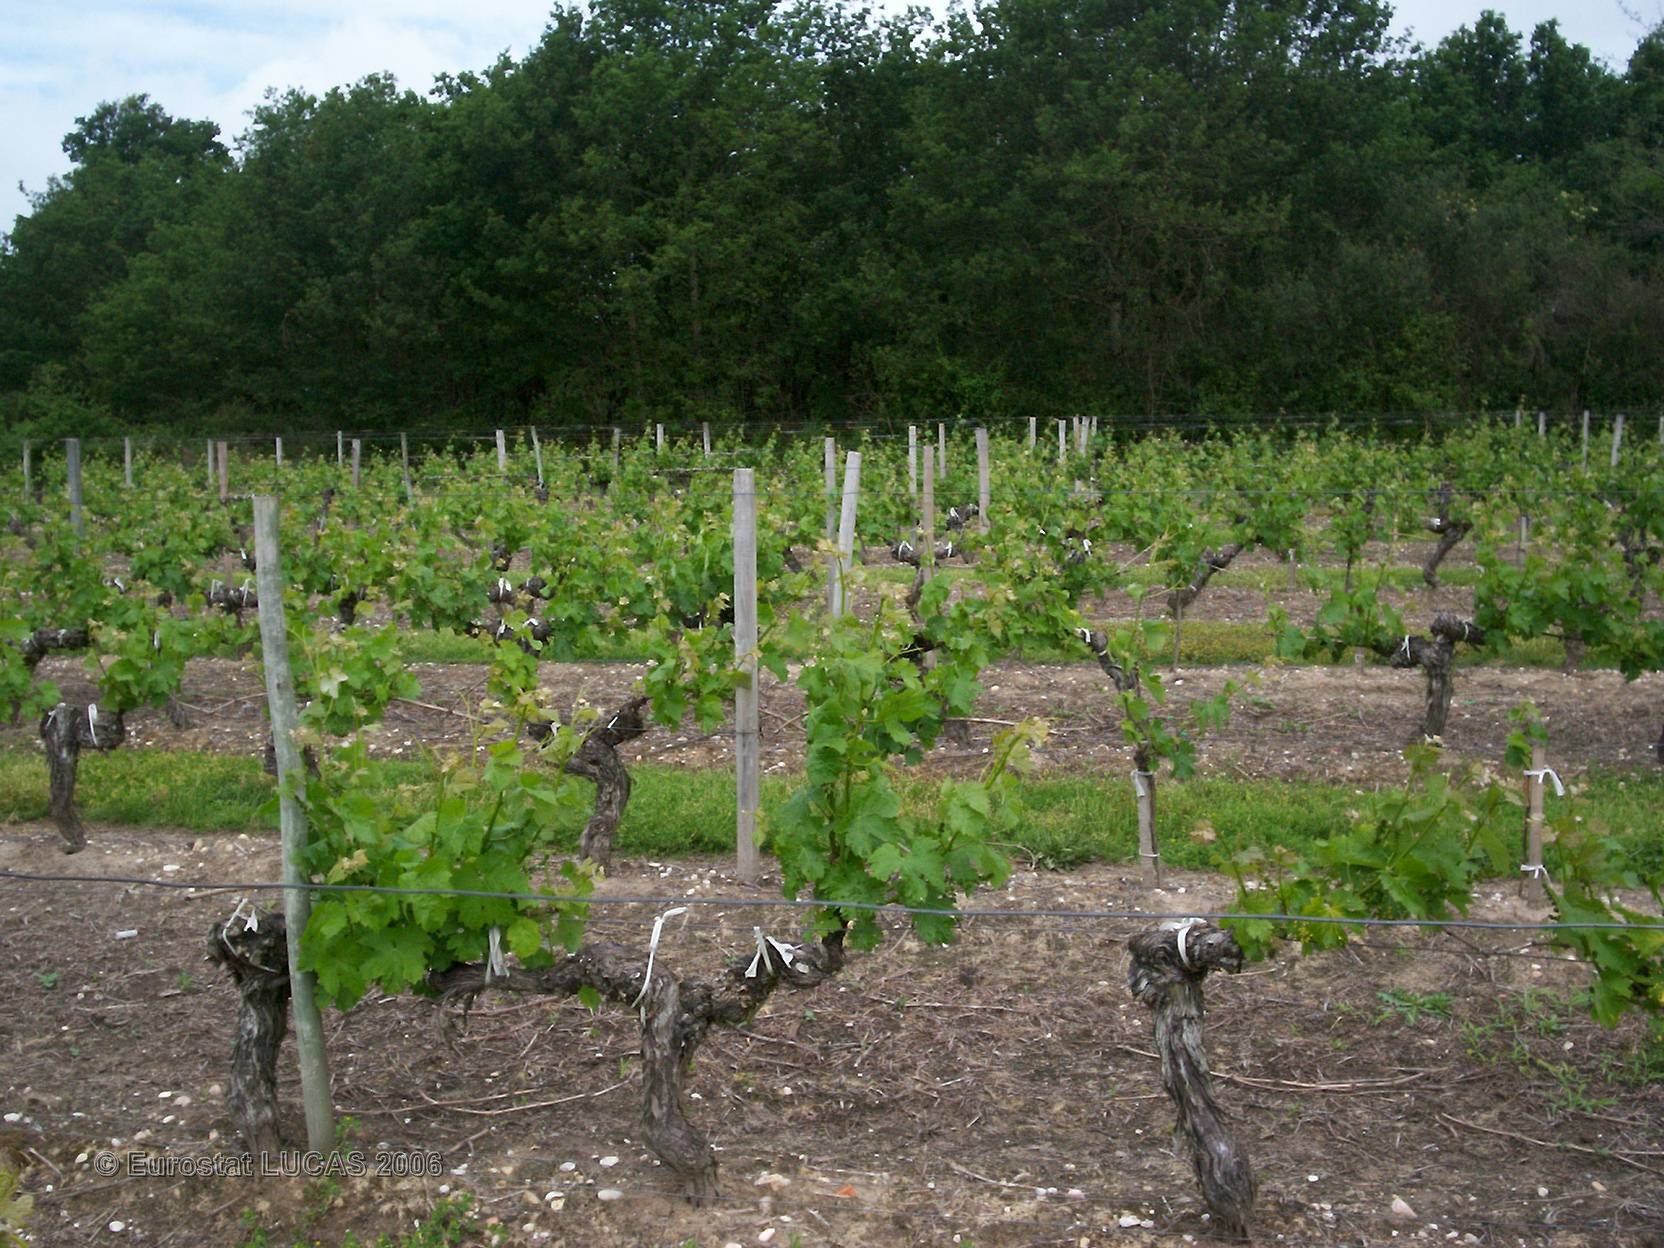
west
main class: Cropland
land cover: Vineyards
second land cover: Grassland with sparse tree/shrub cover
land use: Agriculture (excluding fallow land and kitchen gardens)
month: May
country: FR
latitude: 45.4031
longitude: -0.9746
